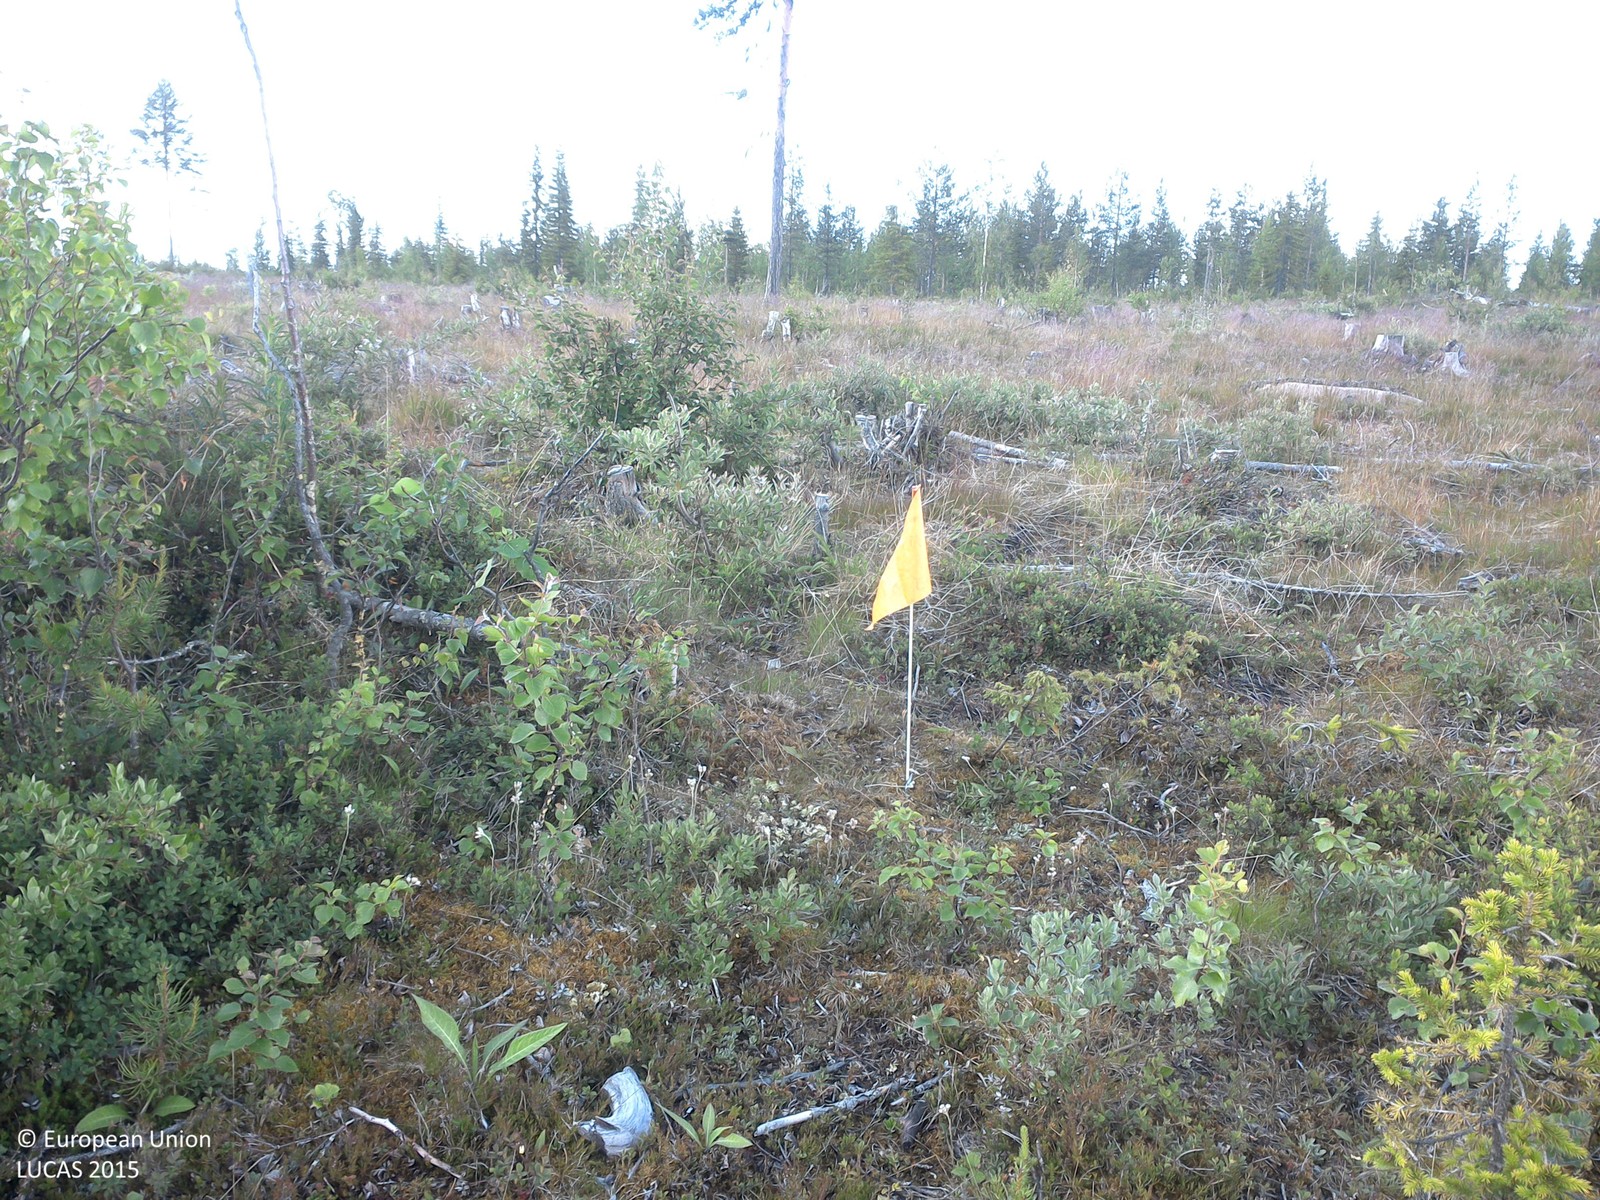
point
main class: Shrubland
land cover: Shrubland with sparse tree cover
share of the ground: 25 - 50 %
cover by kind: herbaceous plants 40 %, shrubs 25 %, unconsolidated bare surface 20 %, lichens and mosses 10 %, broadleaved forest trees 5 %
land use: Forestry
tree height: < 5 m
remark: Clear cut
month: July
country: SE
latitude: 67.7076
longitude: 23.4541
